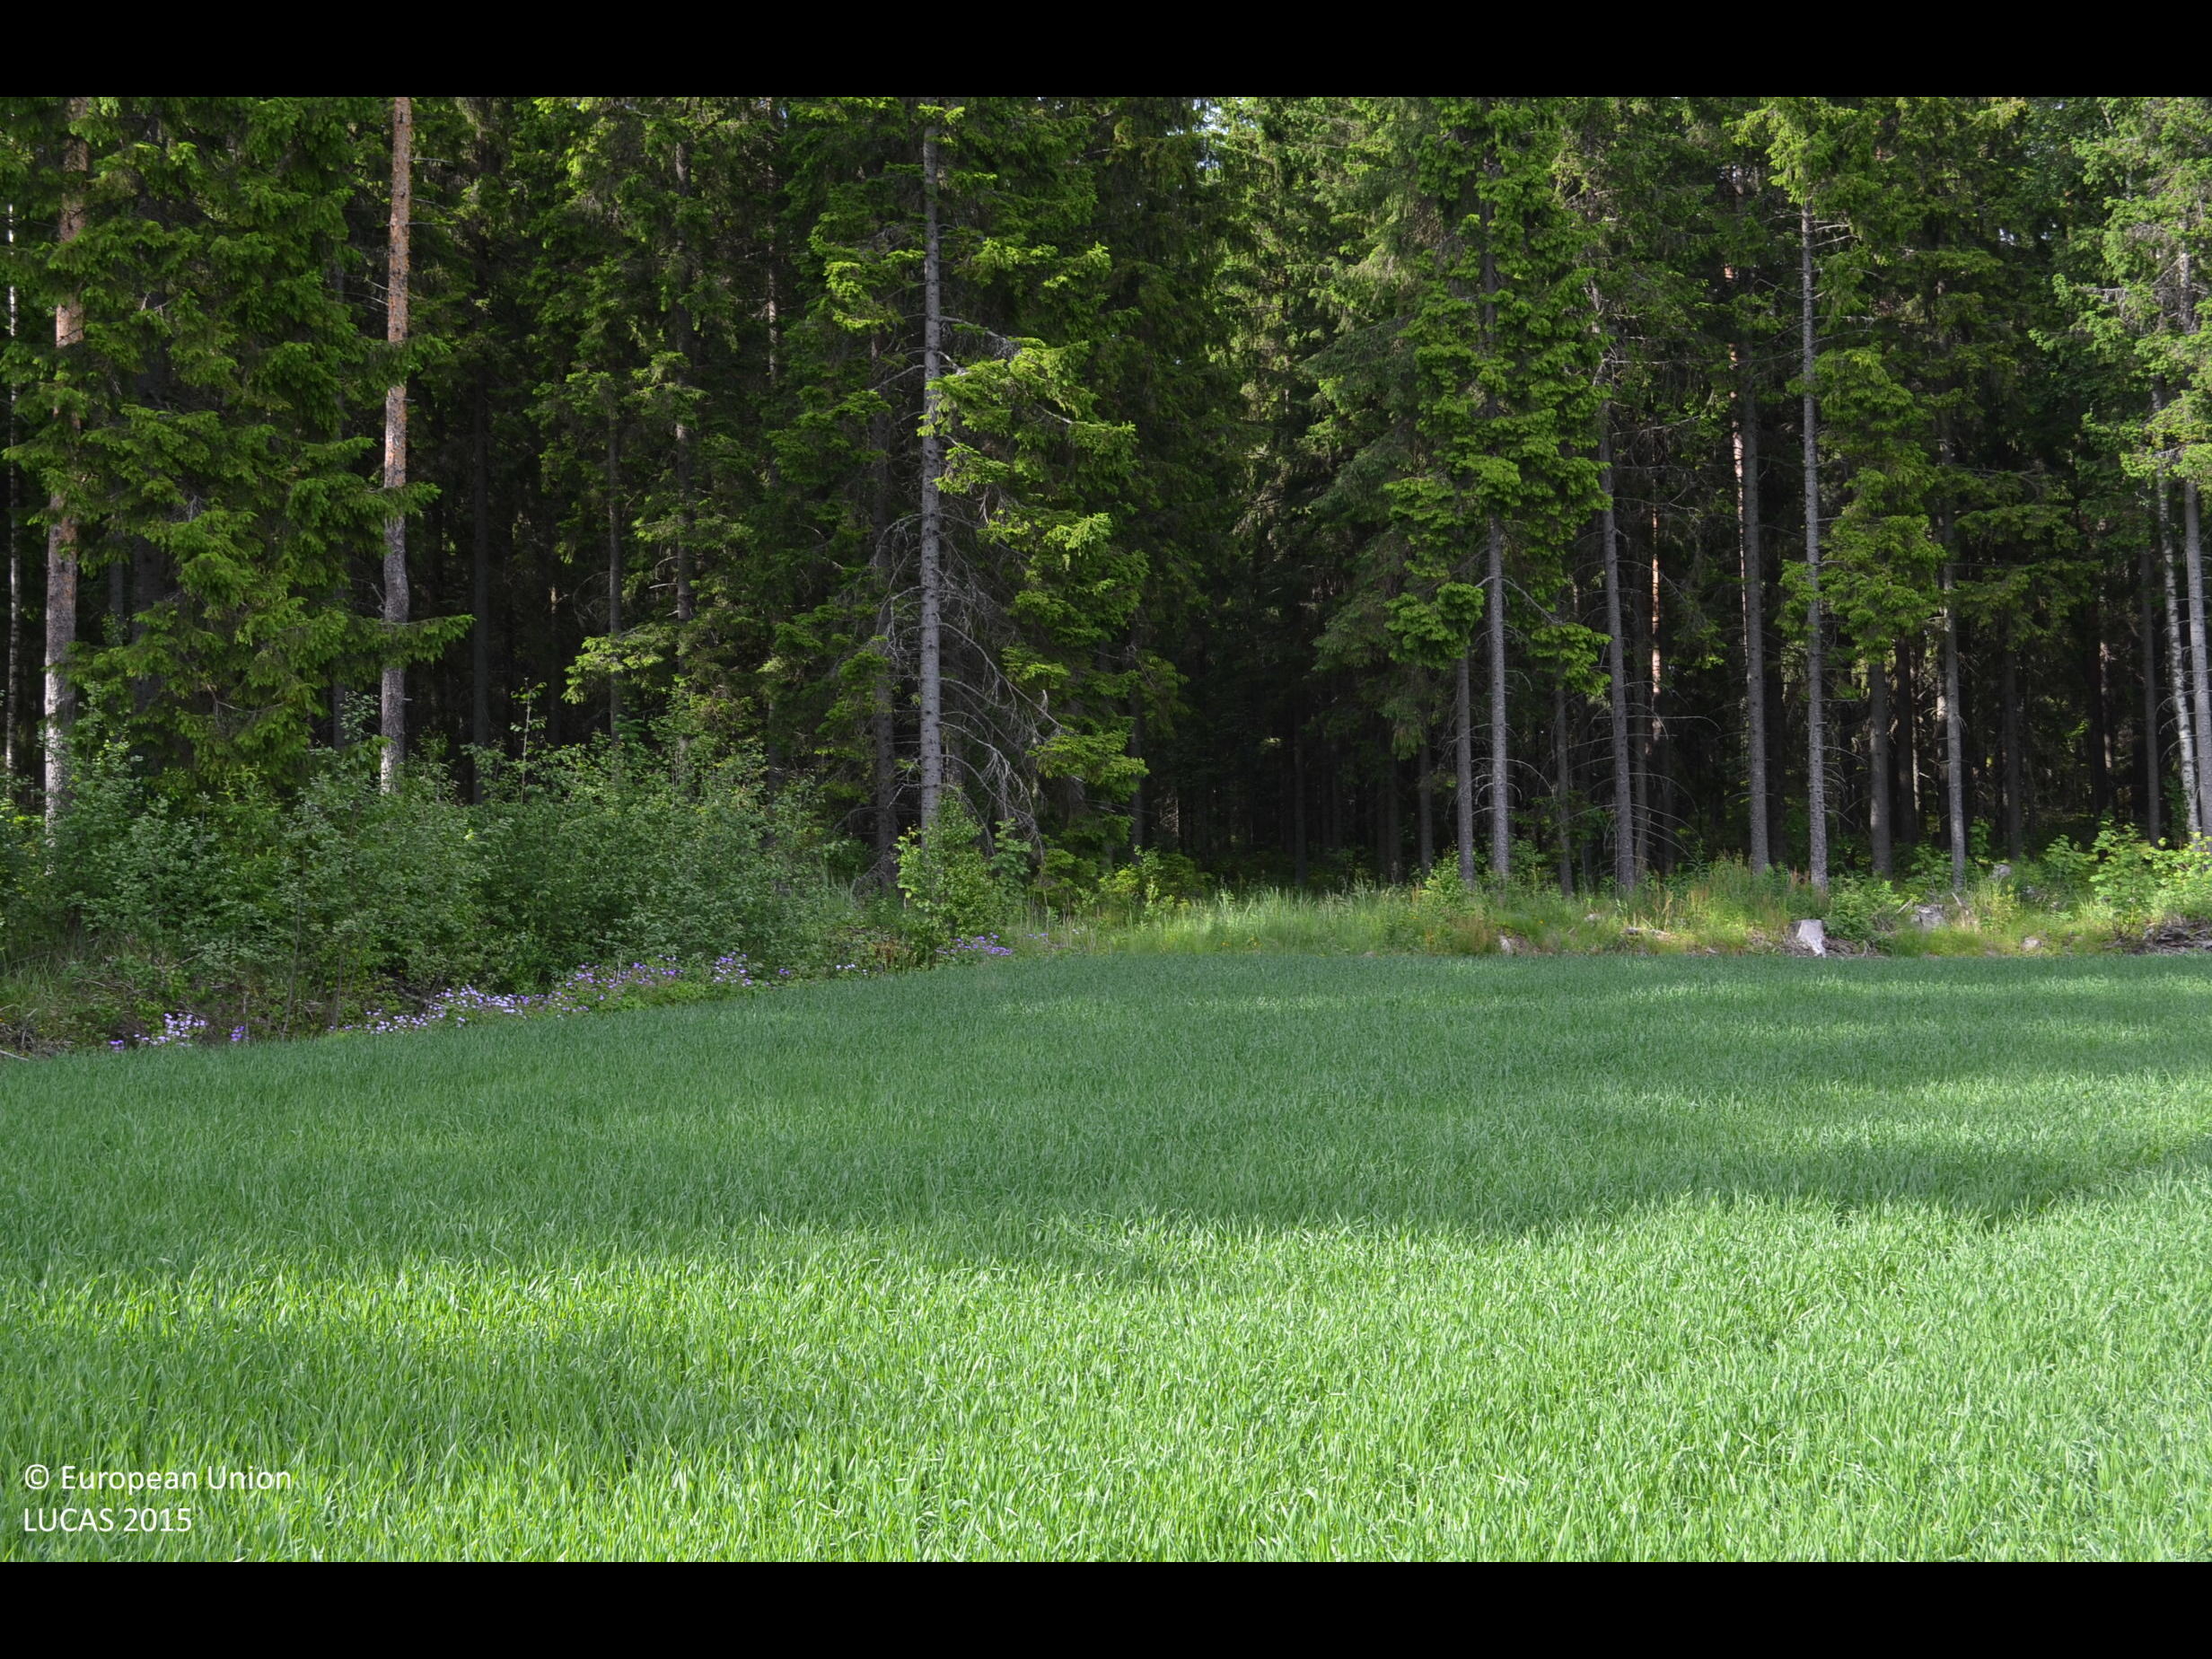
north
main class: Cropland
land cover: Oats
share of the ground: > 75 %
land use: Agriculture (excluding fallow land and kitchen gardens)
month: June
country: FI
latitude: 61.8171
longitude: 23.3026
